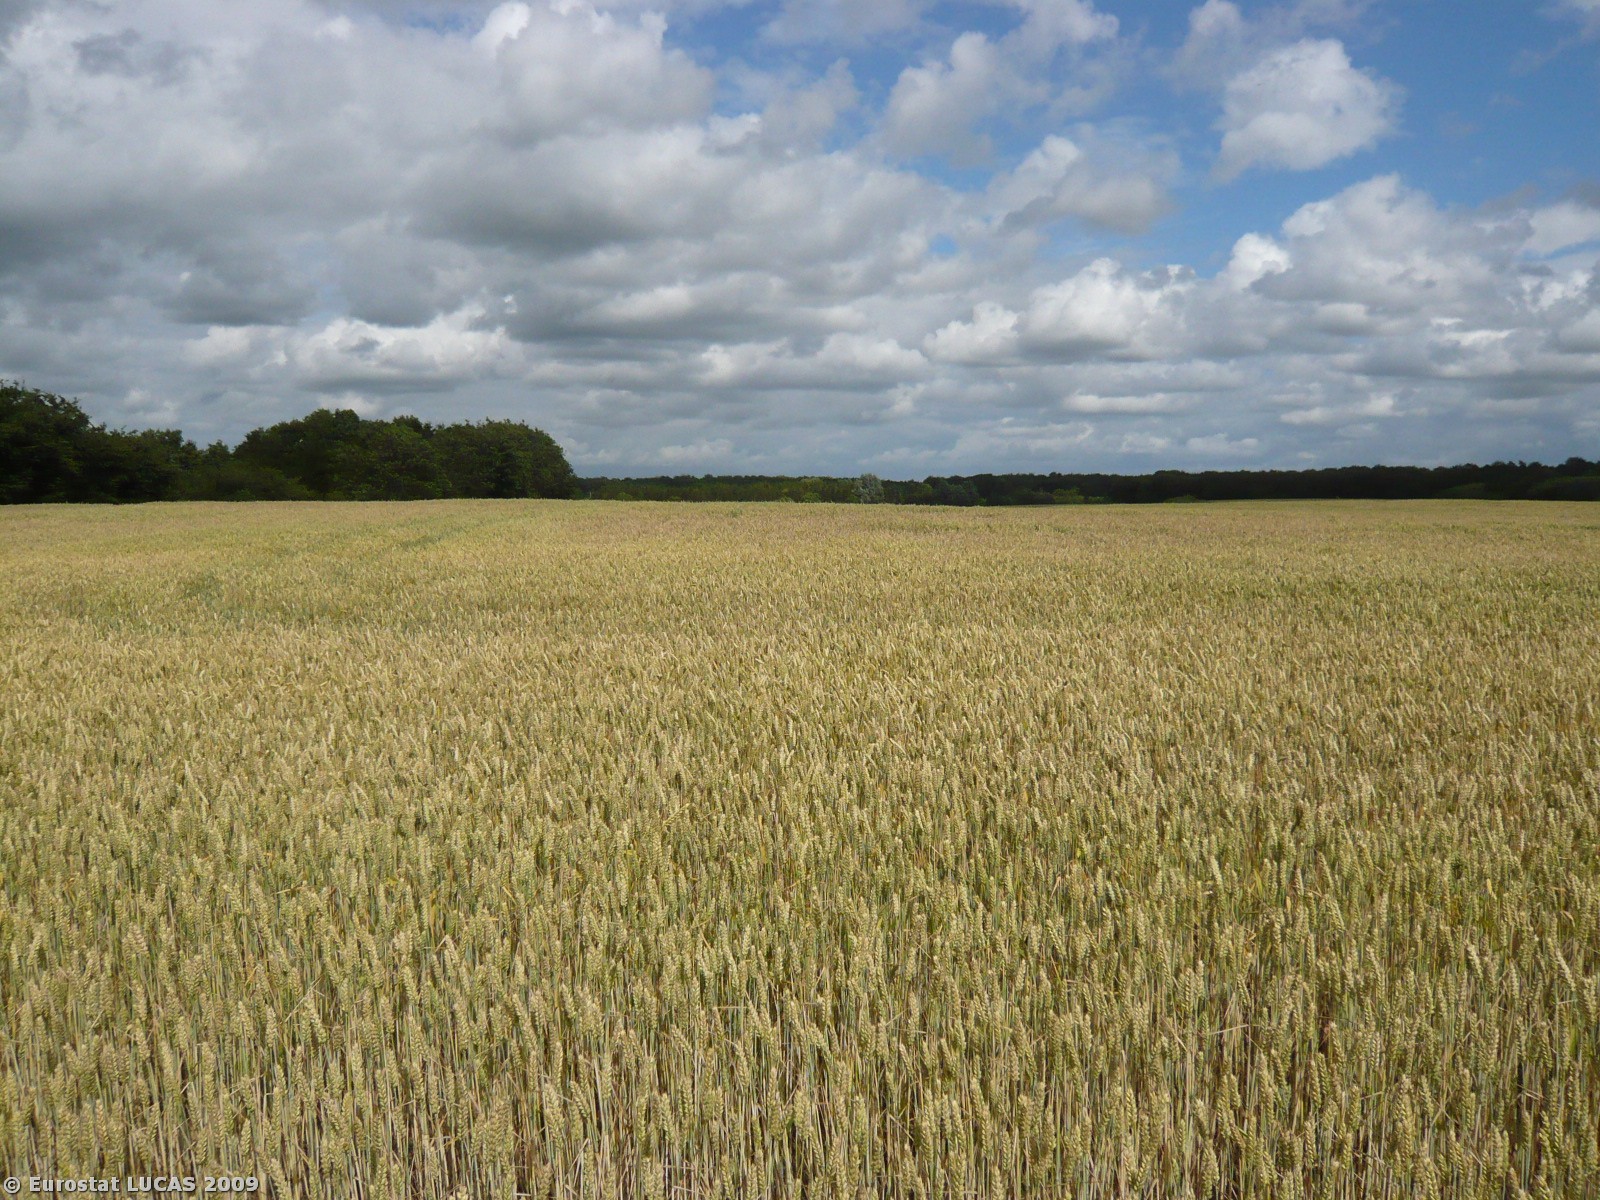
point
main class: Cropland
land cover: Common wheat
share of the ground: > 75 %
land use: Agriculture (excluding fallow land and kitchen gardens)
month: July
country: DK
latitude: 55.4965
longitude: 11.4392
